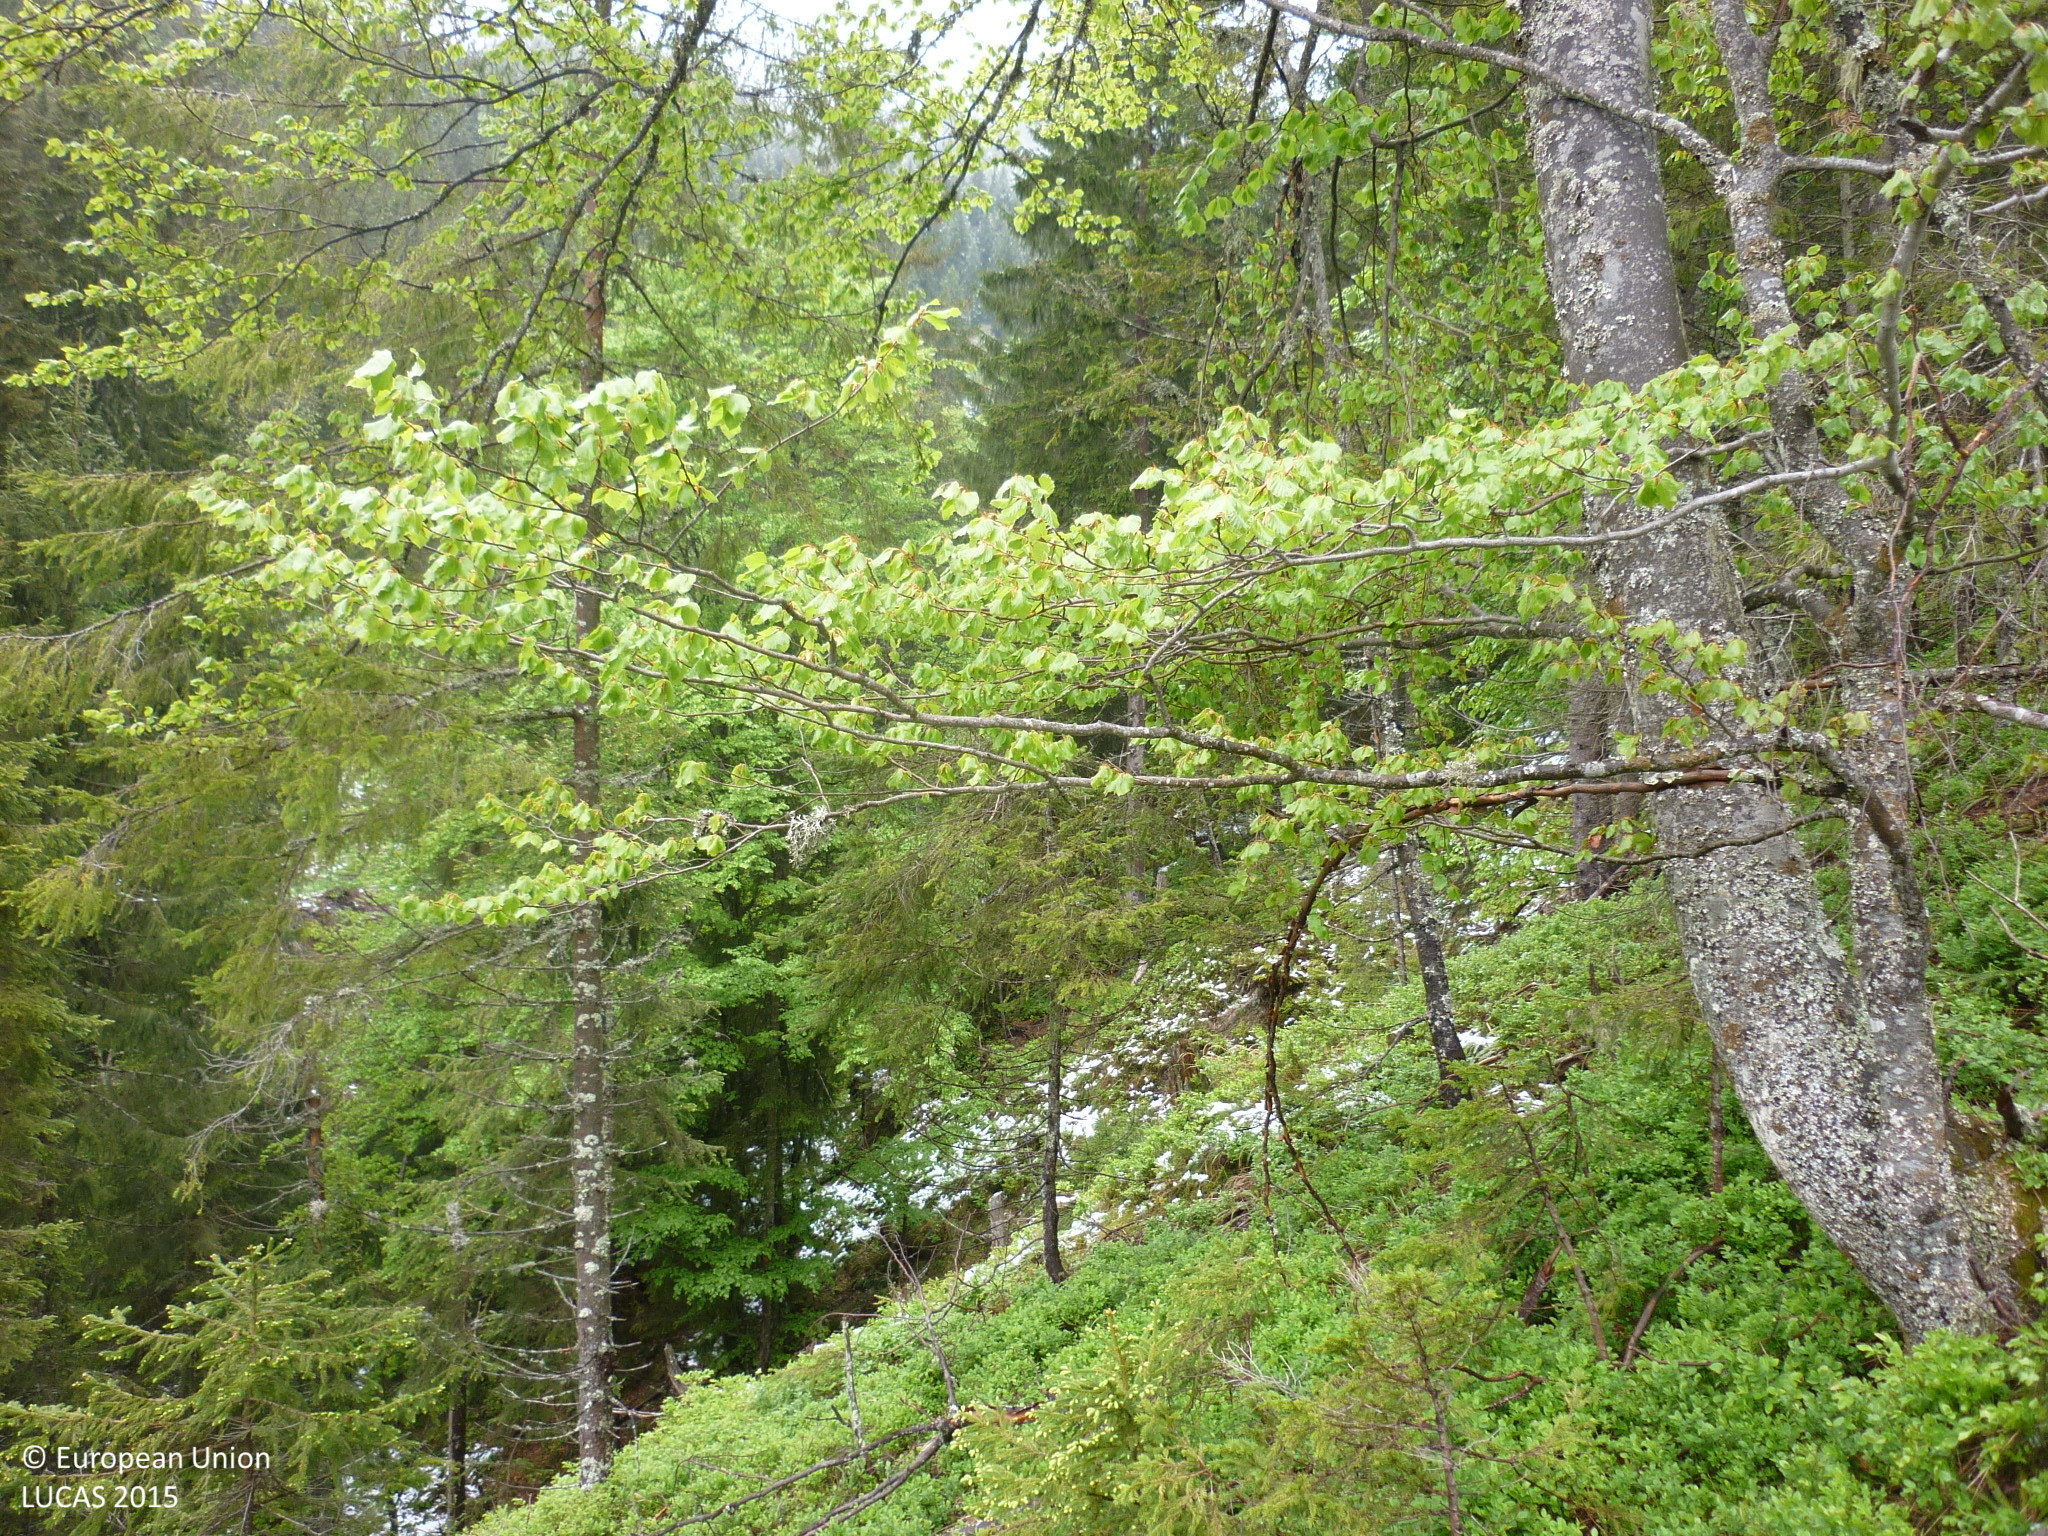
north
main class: Shrubland
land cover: Shrubland with sparse tree cover
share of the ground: > 75 %
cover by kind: shrubs 80 %, herbaceous plants 15 %, coniferous forest trees 5 %
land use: Forestry
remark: Clear cut
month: May
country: AT
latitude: 47.4459
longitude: 14.5213
